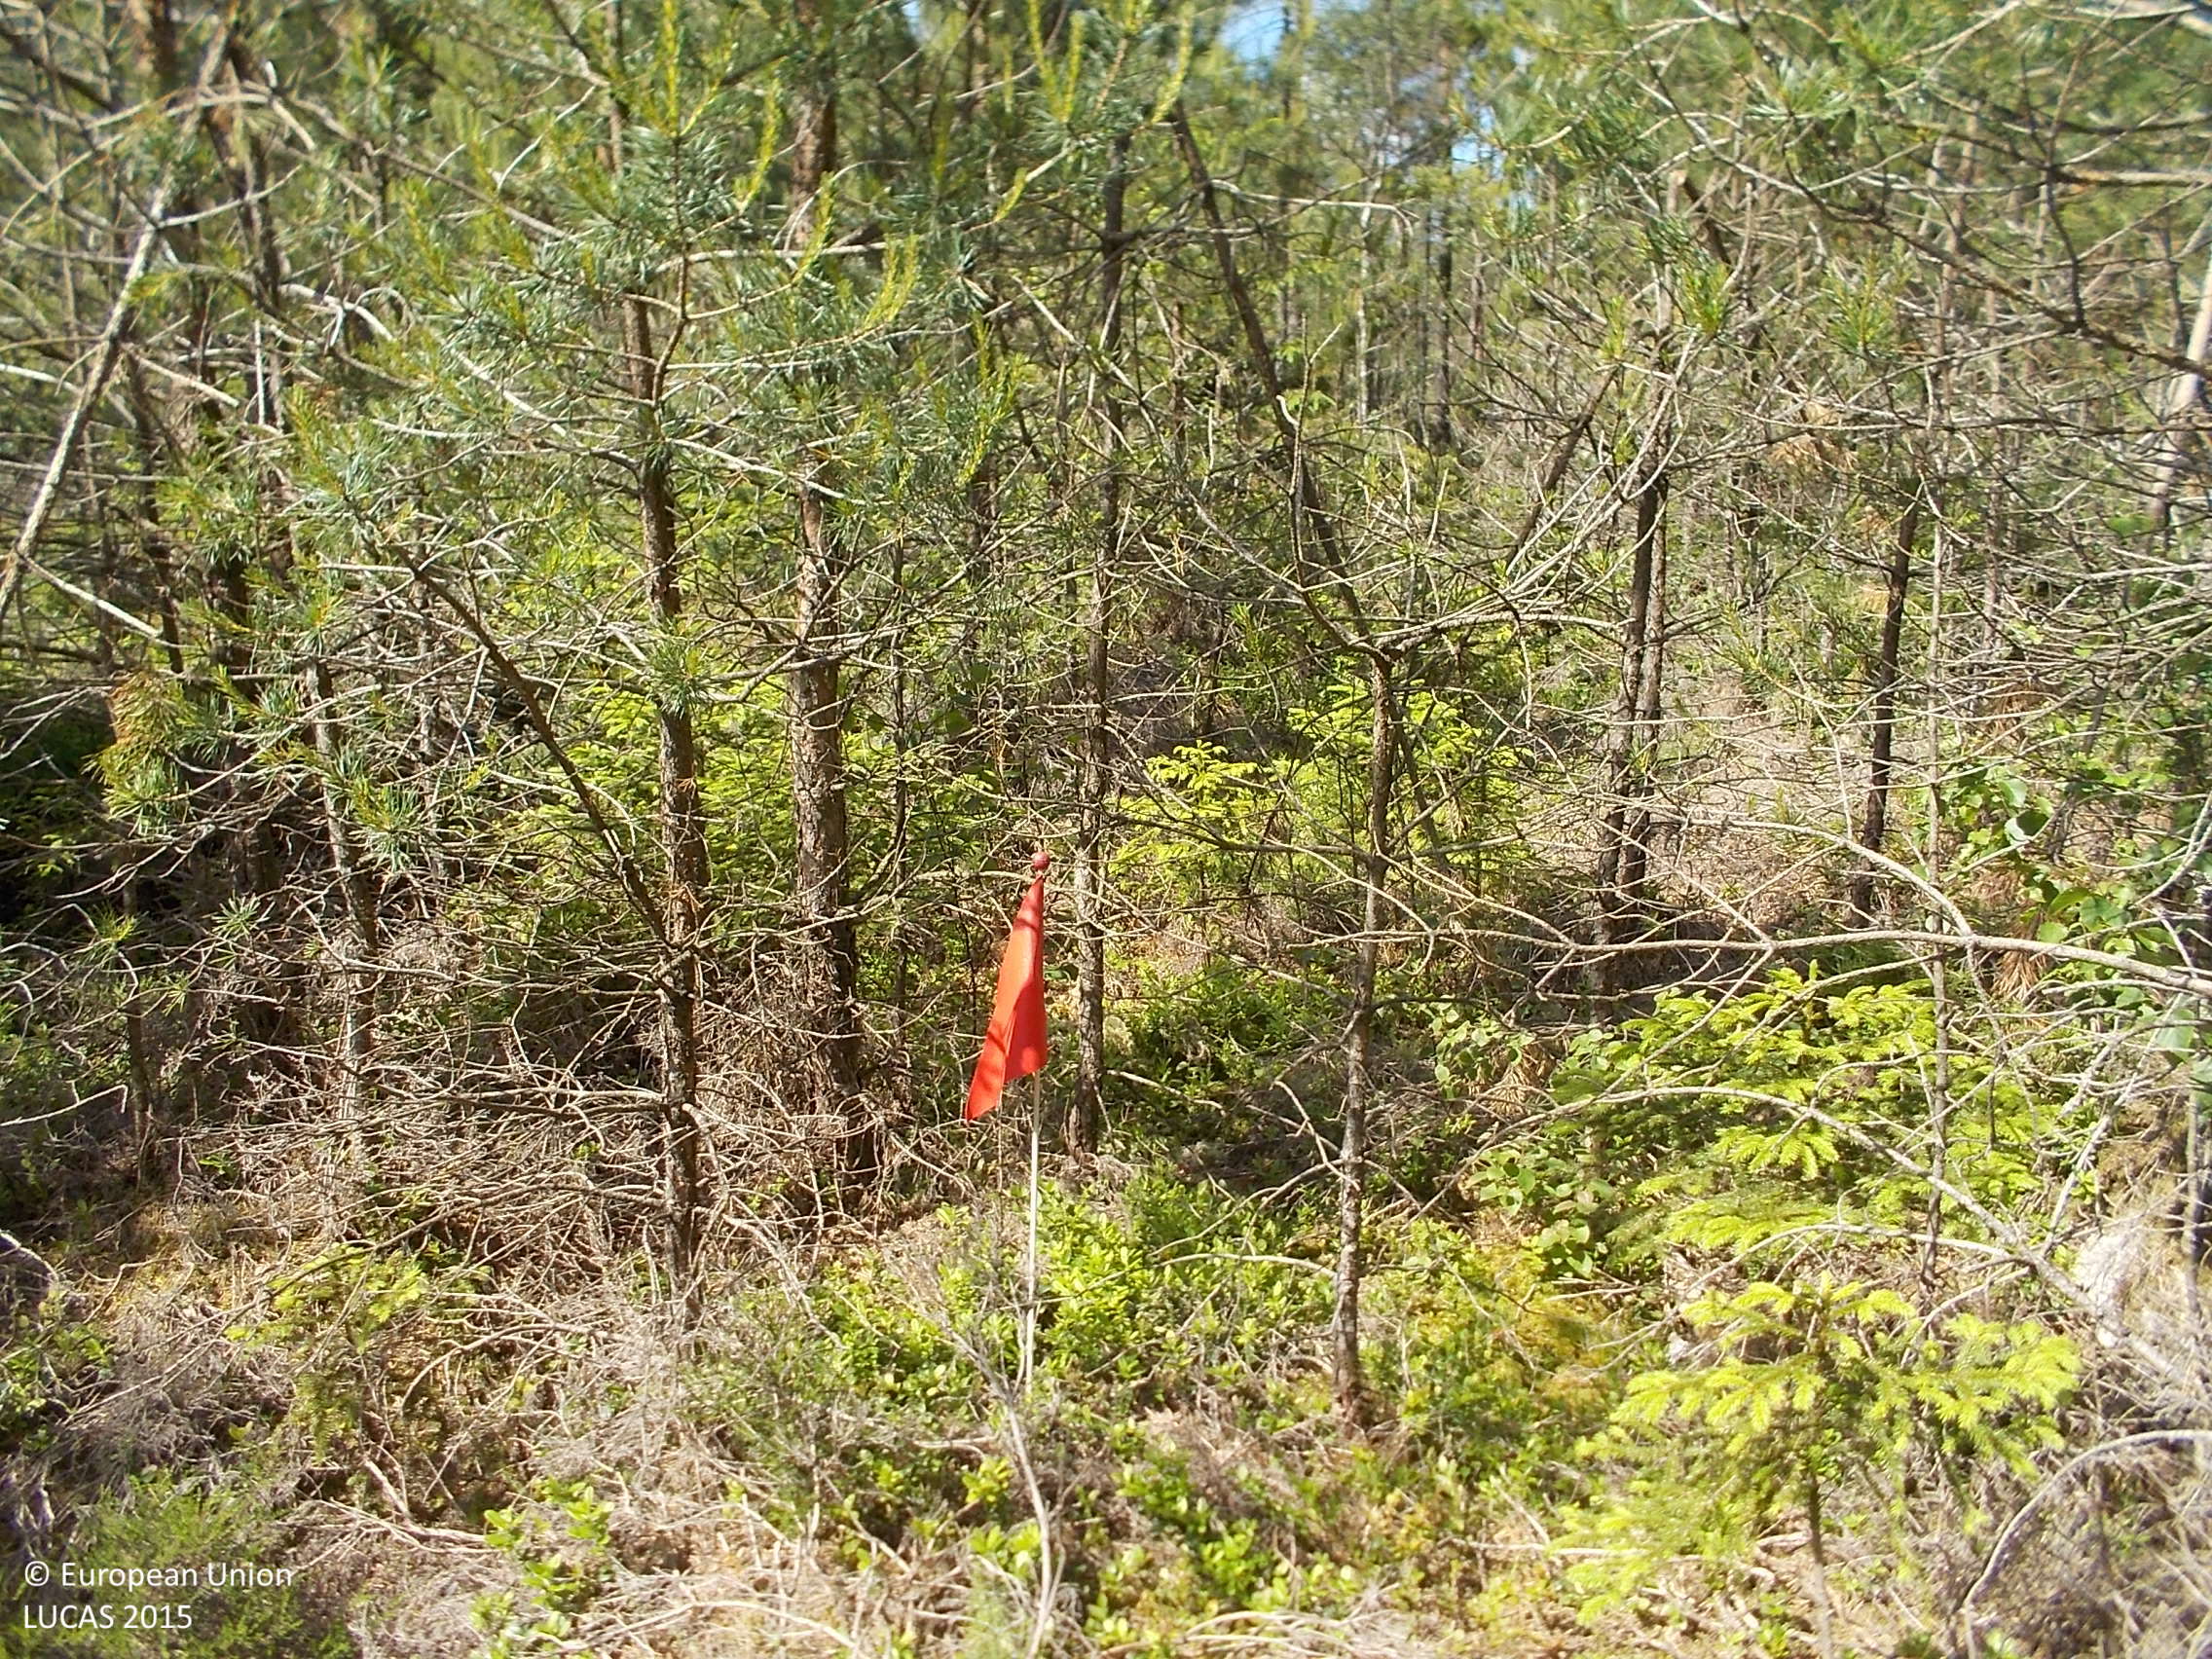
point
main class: Woodland
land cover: Pine dominated coniferous woodland
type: boreal forest
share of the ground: 50 - 75 %
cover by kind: coniferous forest trees 70 %, shrubs 25 %, broadleaved forest trees 5 %
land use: Forestry
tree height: < 5 m
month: June
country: SE
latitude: 57.7501
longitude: 12.2981
